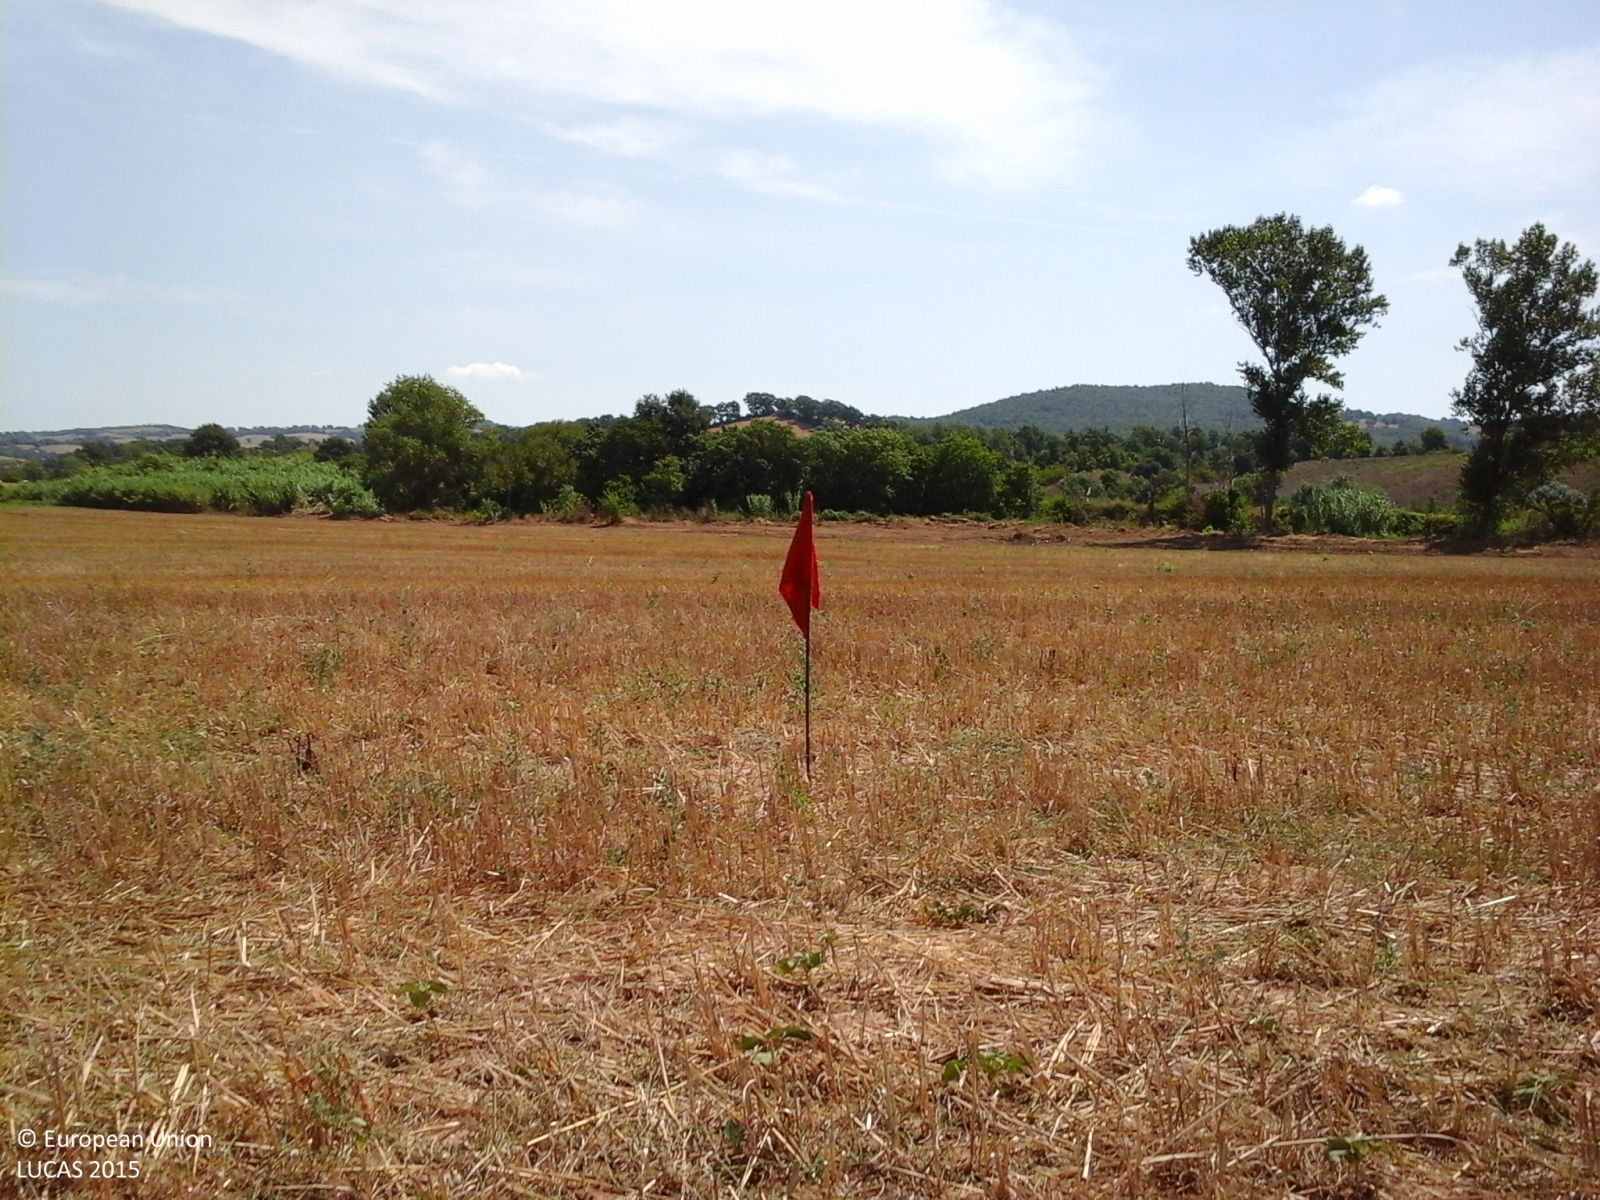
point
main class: Cropland
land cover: Barley
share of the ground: > 75 %
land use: Agriculture (excluding fallow land and kitchen gardens)
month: August
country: IT
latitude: 42.5354
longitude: 11.4439
